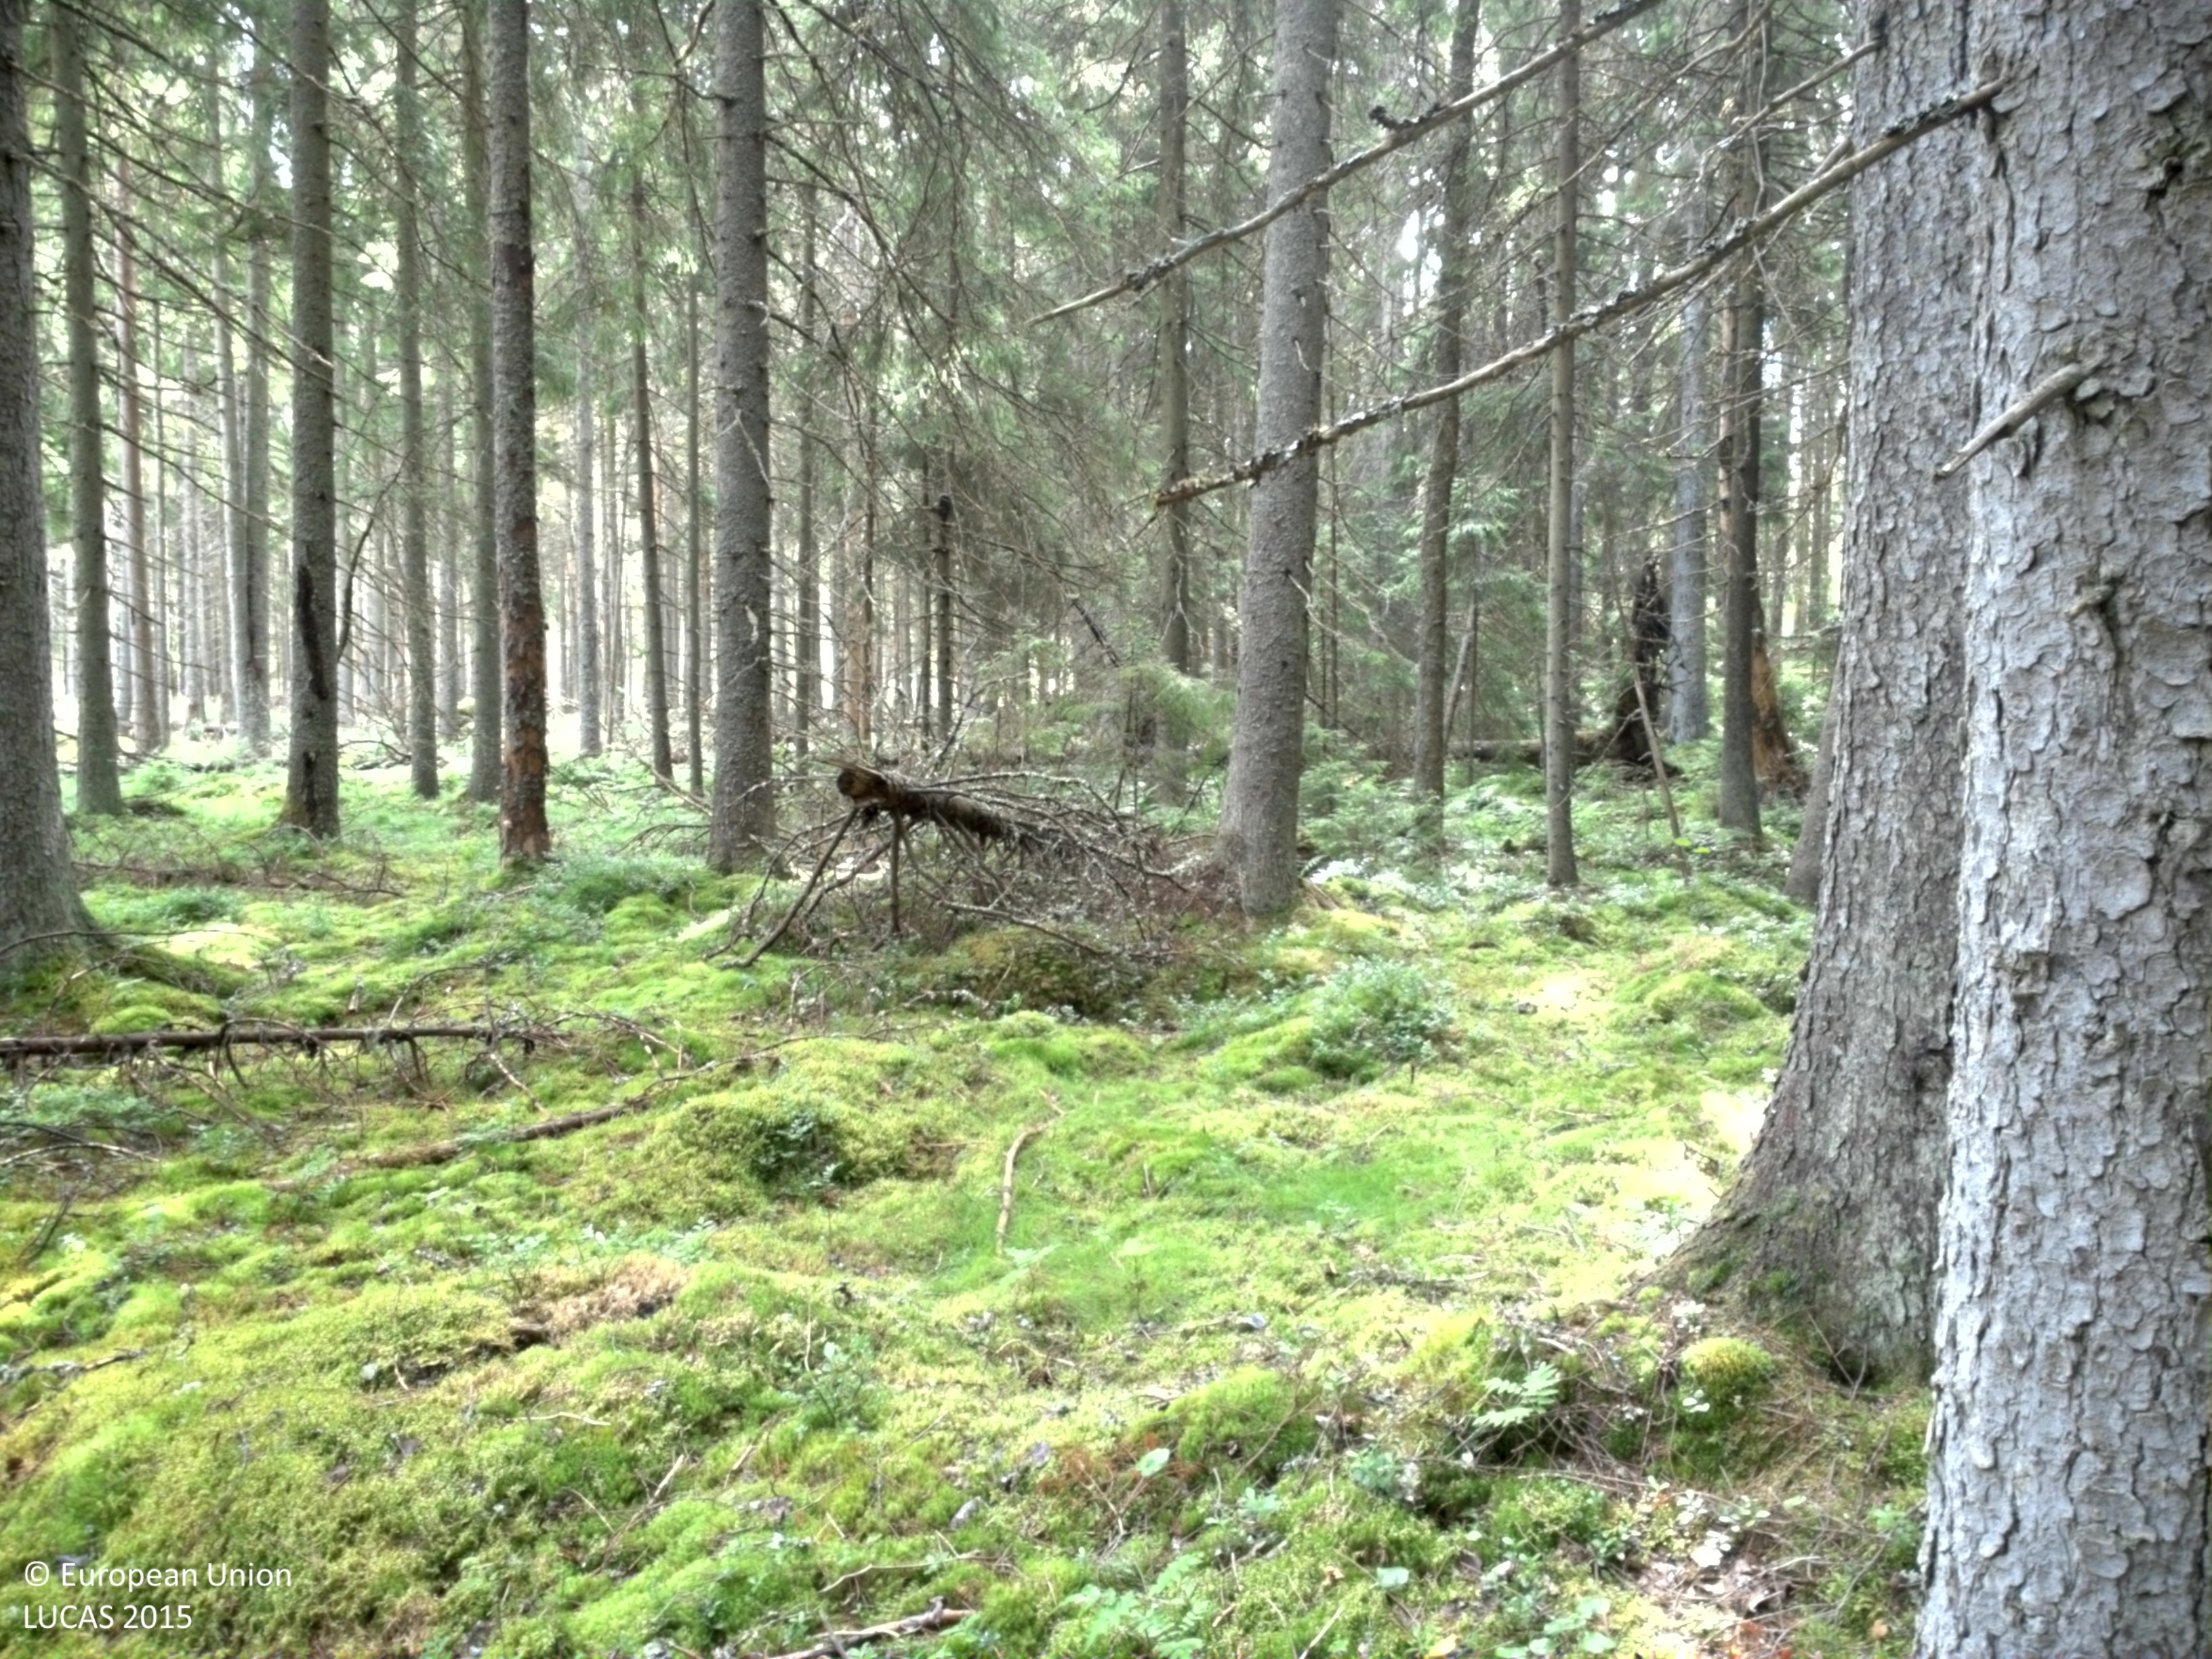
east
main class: Woodland
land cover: Spruce dominated coniferous woodland
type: boreal forest
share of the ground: 50 - 75 %
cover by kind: coniferous forest trees 70 %, lichens and mosses 30 %
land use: Forestry
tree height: > 5 m
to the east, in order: Spruce dominated coniferous woodland; Ditches and canals; Broadleaved woodland; Electric lines; Broadleaved woodland; Spruce dominated coniferous woodland; Ditches and canals; Spruce dominated coniferous woodland
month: July
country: SE
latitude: 57.6195
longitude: 14.5660
